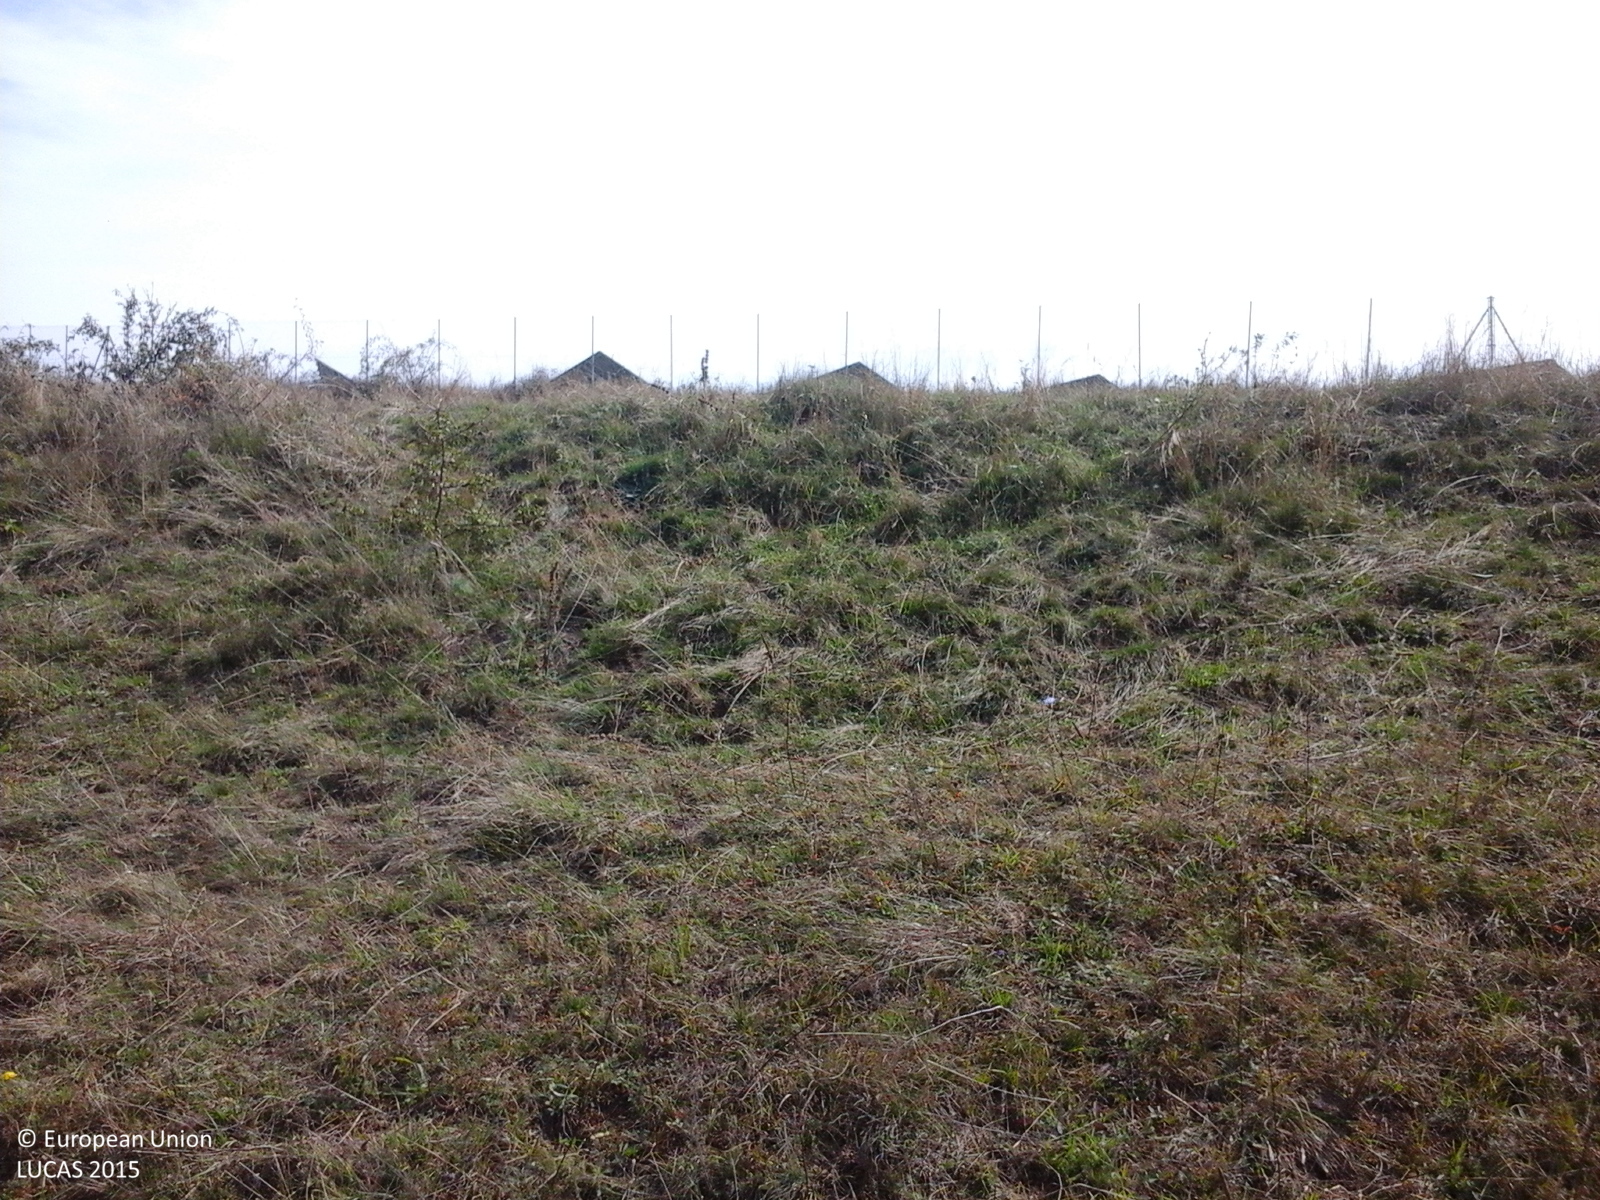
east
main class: Grassland
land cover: Grassland with sparse tree/shrub cover
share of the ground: > 75 %
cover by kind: herbaceous plants 85 %, shrubs 10 %, broadleaved forest trees 5 %
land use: Agriculture (excluding fallow land and kitchen gardens)
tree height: < 5 m
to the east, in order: Grassland with sparse tree/shrub cover; Tracks; Grassland with sparse tree/shrub cover; Artificial constructions in urban areas
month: September
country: RO
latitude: 47.1312
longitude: 23.8011
